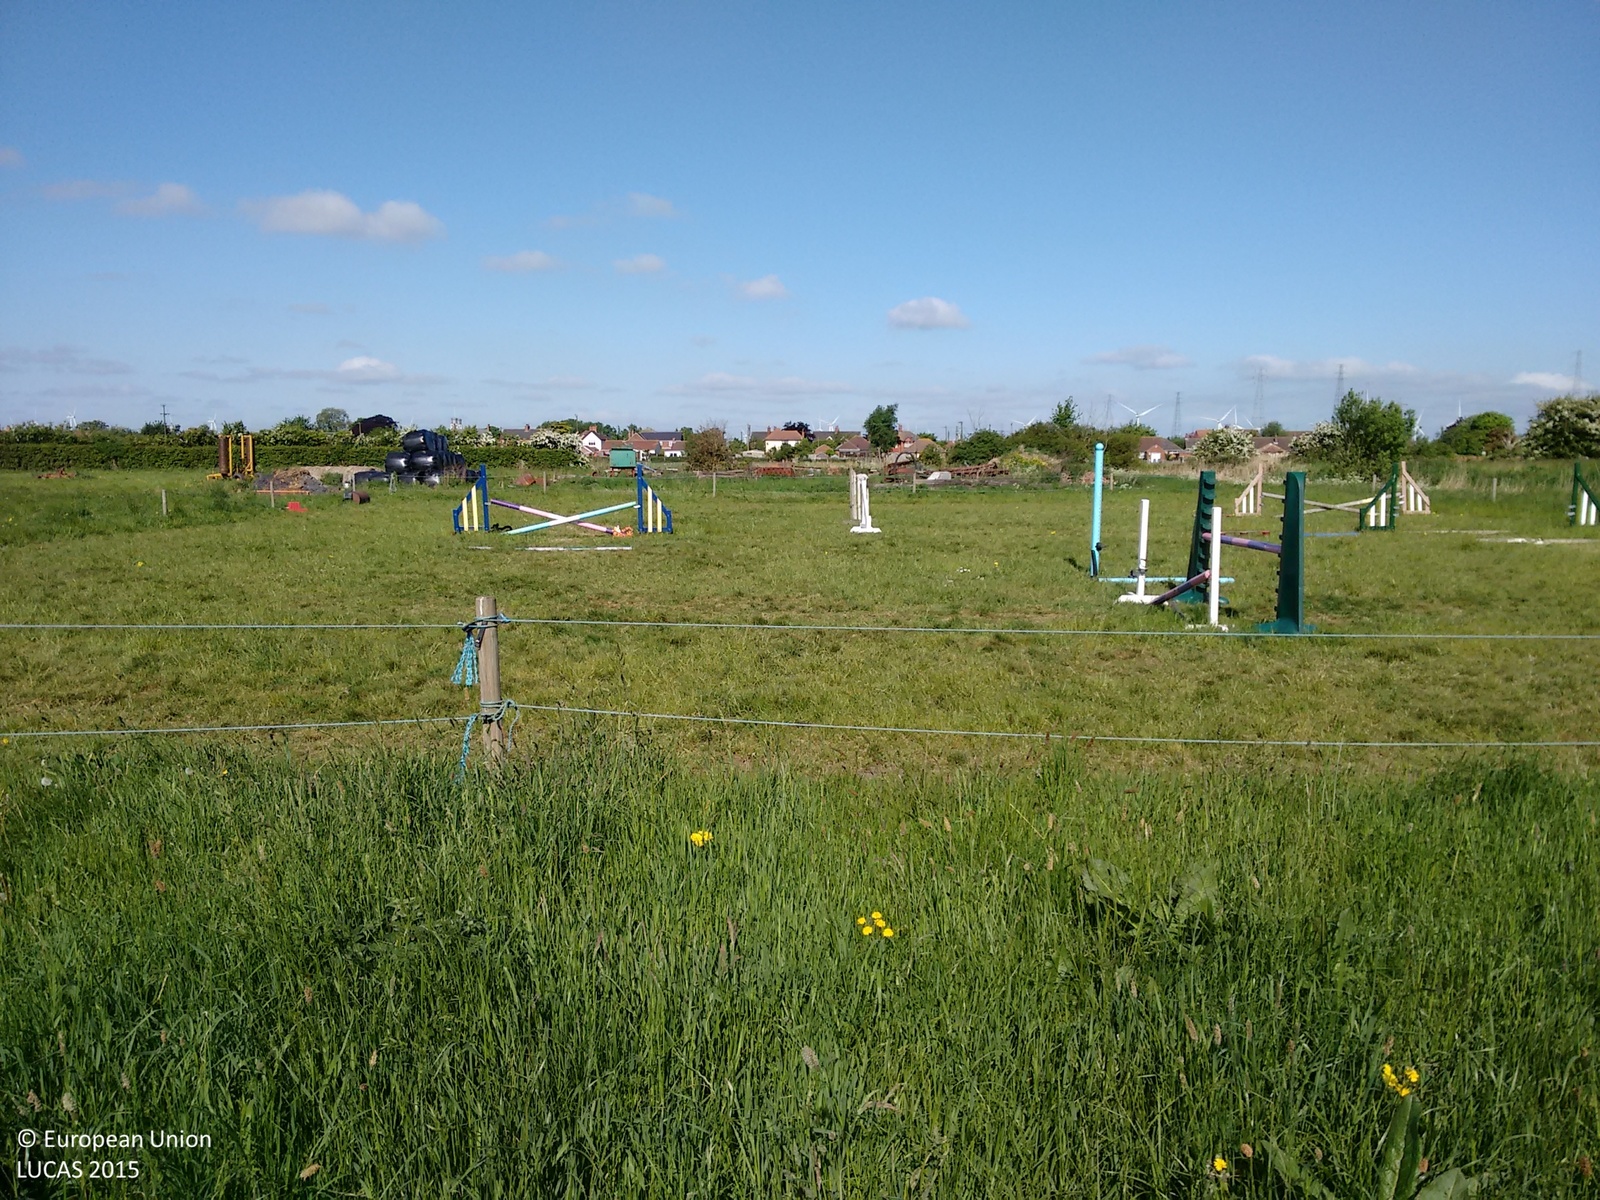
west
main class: Grassland
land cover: Grassland without tree/shrub cover
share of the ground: > 75 %
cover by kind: herbaceous plants 100 %
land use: Agriculture (excluding fallow land and kitchen gardens)
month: May
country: GB
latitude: 53.5957
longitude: -0.7222
